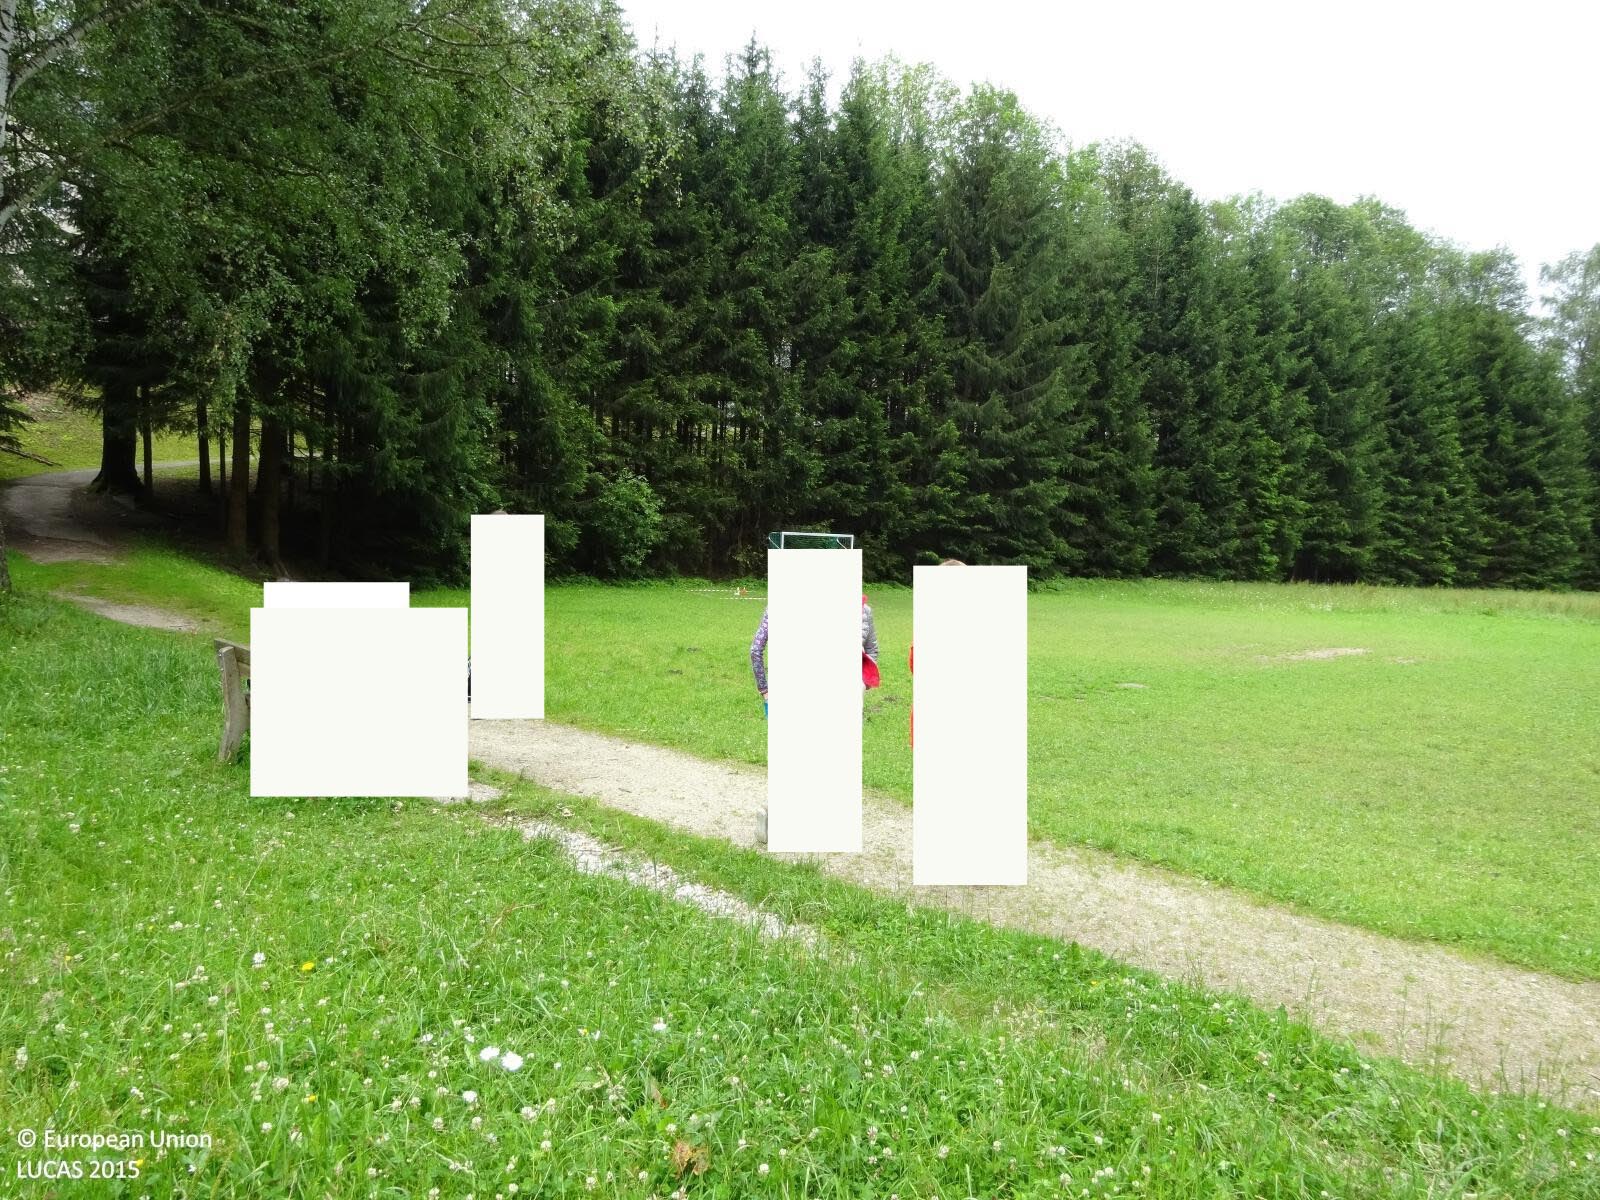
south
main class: Grassland
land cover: Grassland without tree/shrub cover
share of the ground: > 75 %
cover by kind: herbaceous plants 100 %
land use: Amenities, museums, leisure
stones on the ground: < 10 %
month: June
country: AT
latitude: 47.6052
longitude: 15.7348
